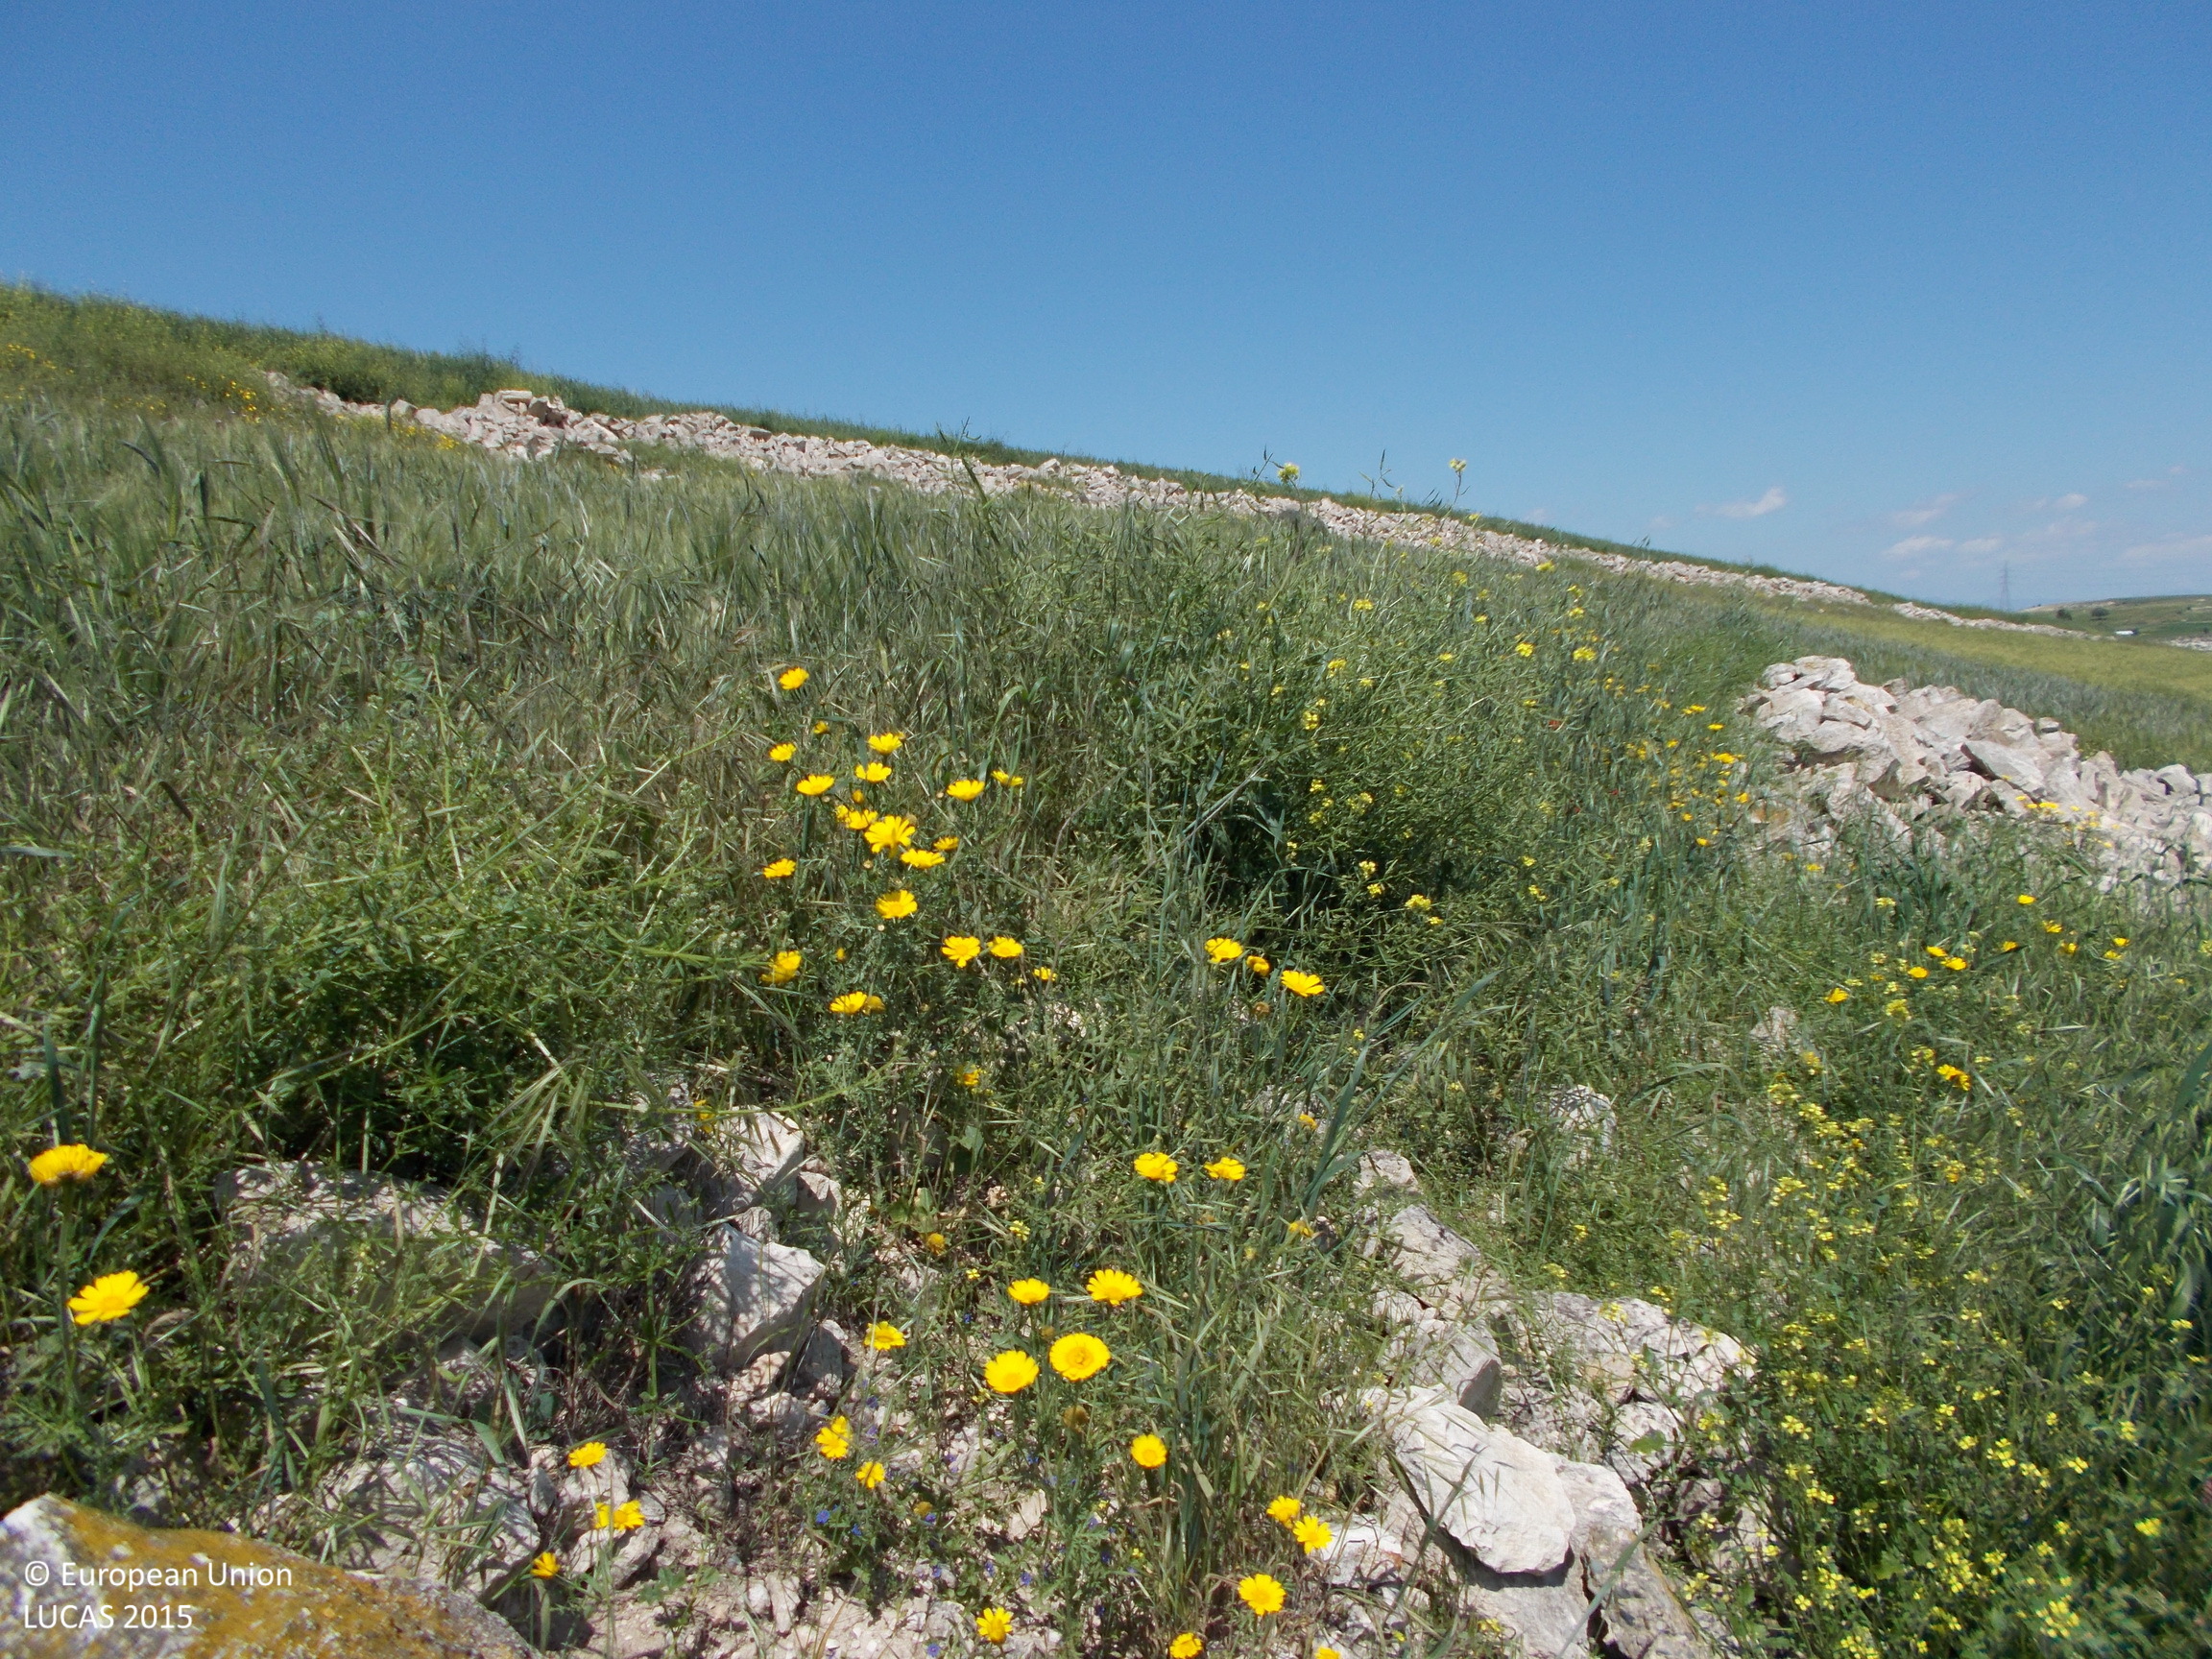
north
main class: Grassland
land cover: Grassland without tree/shrub cover
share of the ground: 25 - 50 %
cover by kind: herbaceous plants 50 %, consolidated bare surface 50 %
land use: Semi-natural and natural areas not in use
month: April
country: CY
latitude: 35.0262
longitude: 33.5533
